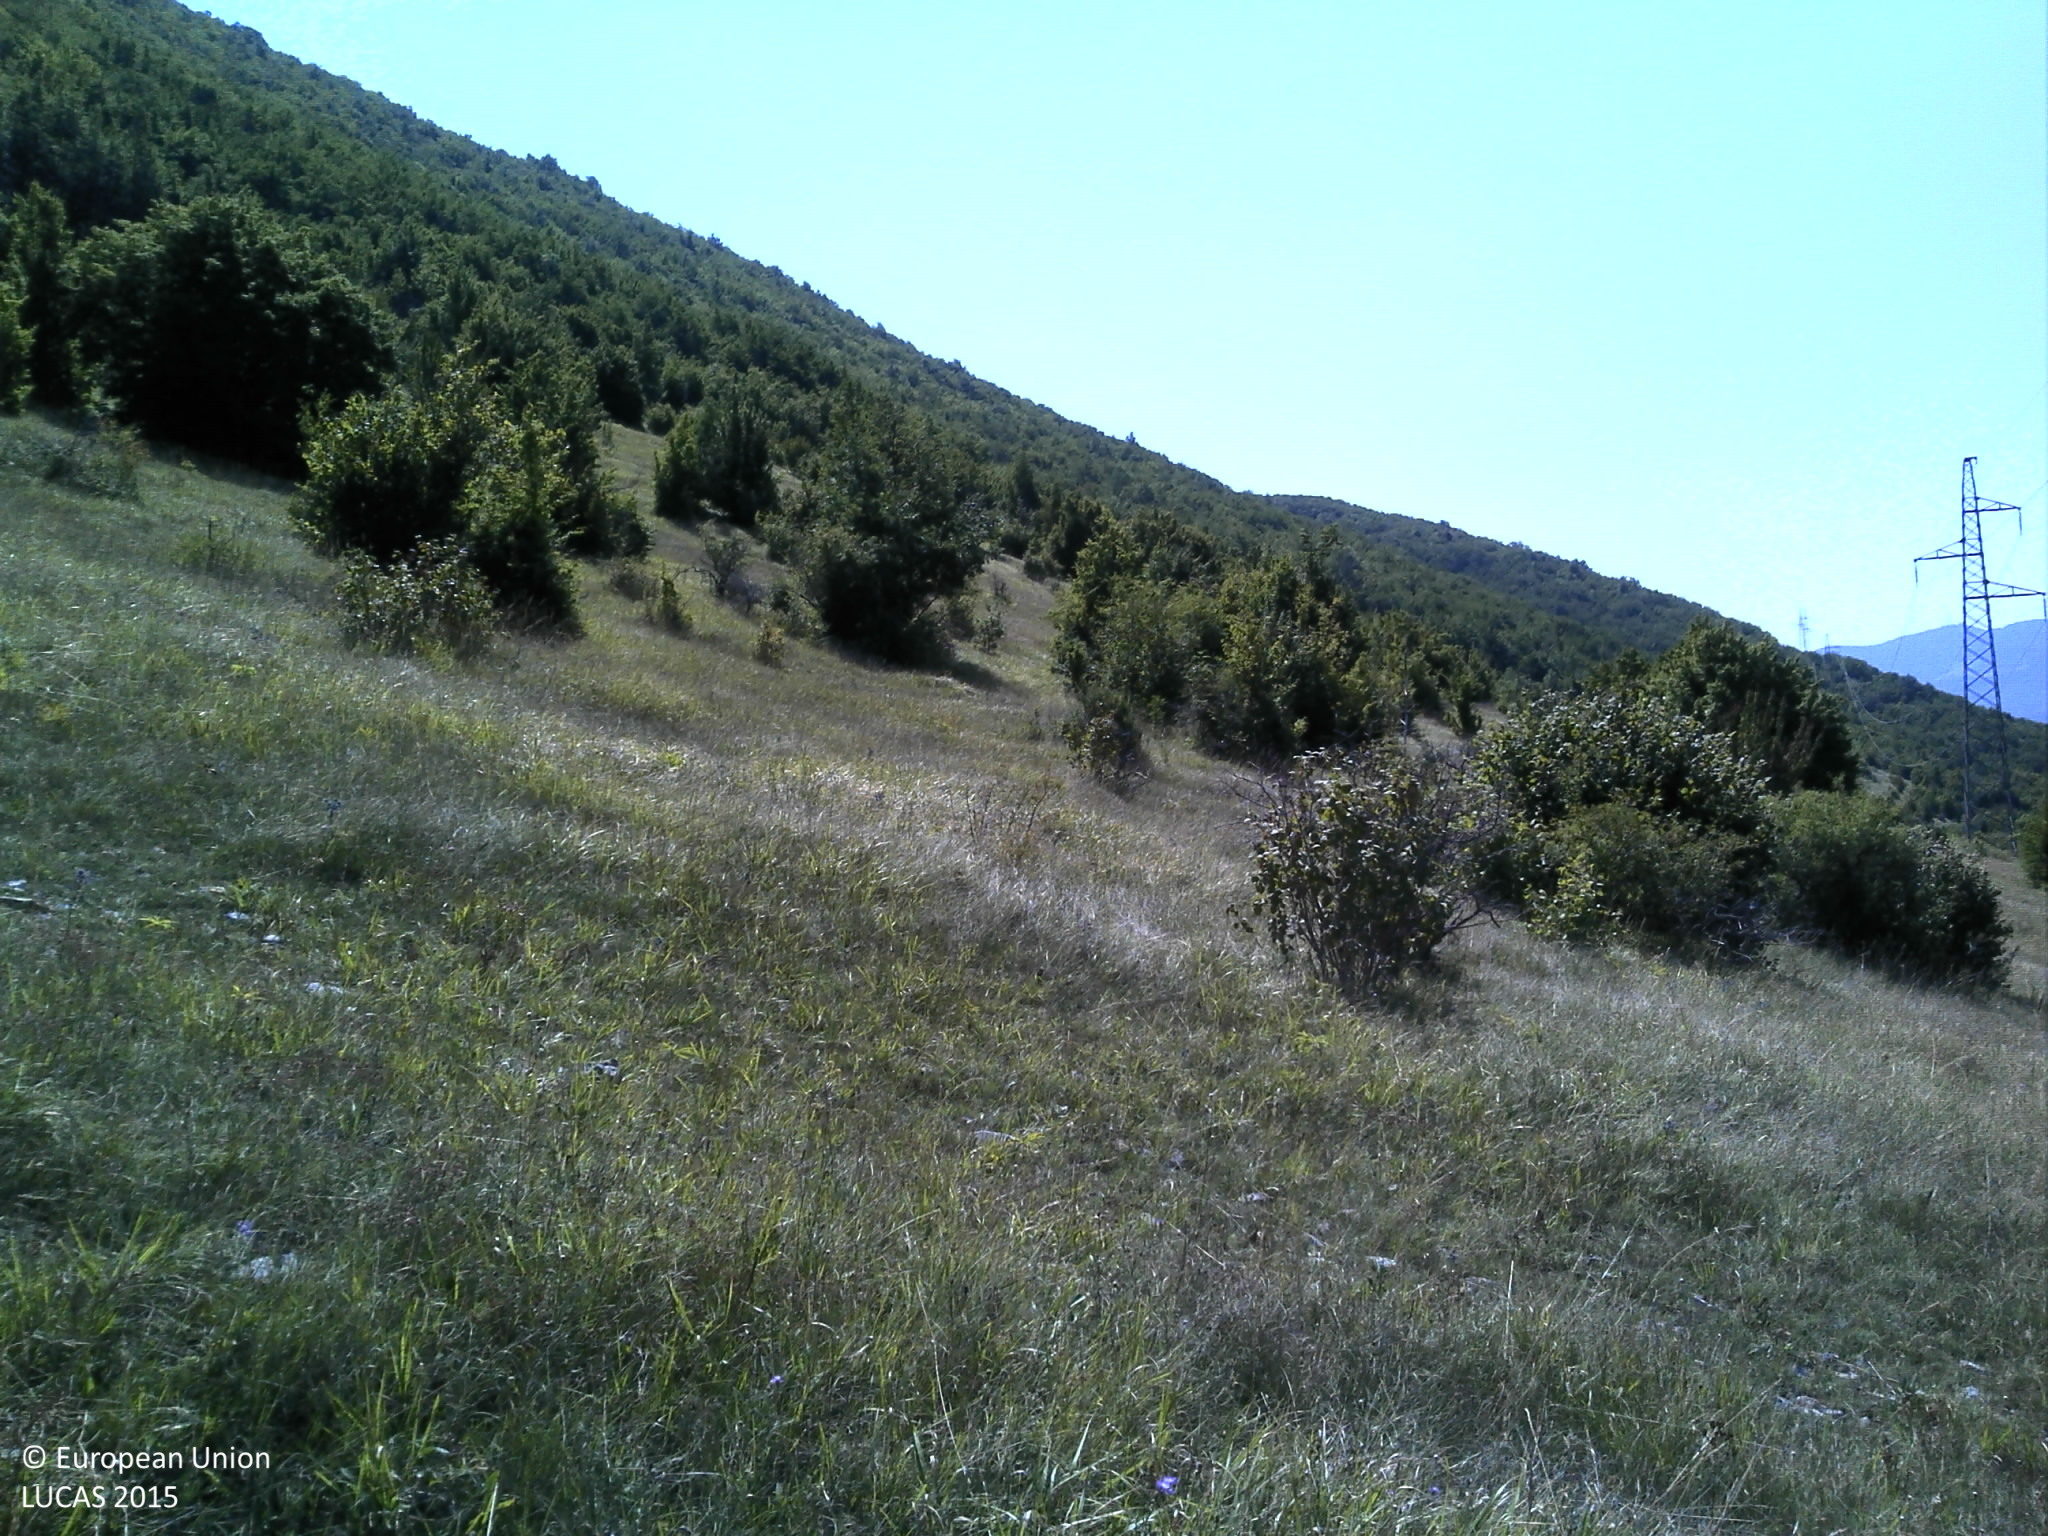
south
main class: Grassland
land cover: Grassland with sparse tree/shrub cover
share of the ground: > 75 %
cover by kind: herbaceous plants 85 %, shrubs 10 %, broadleaved forest trees 5 %
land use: Abandoned areas
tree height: < 5 m
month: August
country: HR
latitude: 44.3288
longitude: 15.8745
